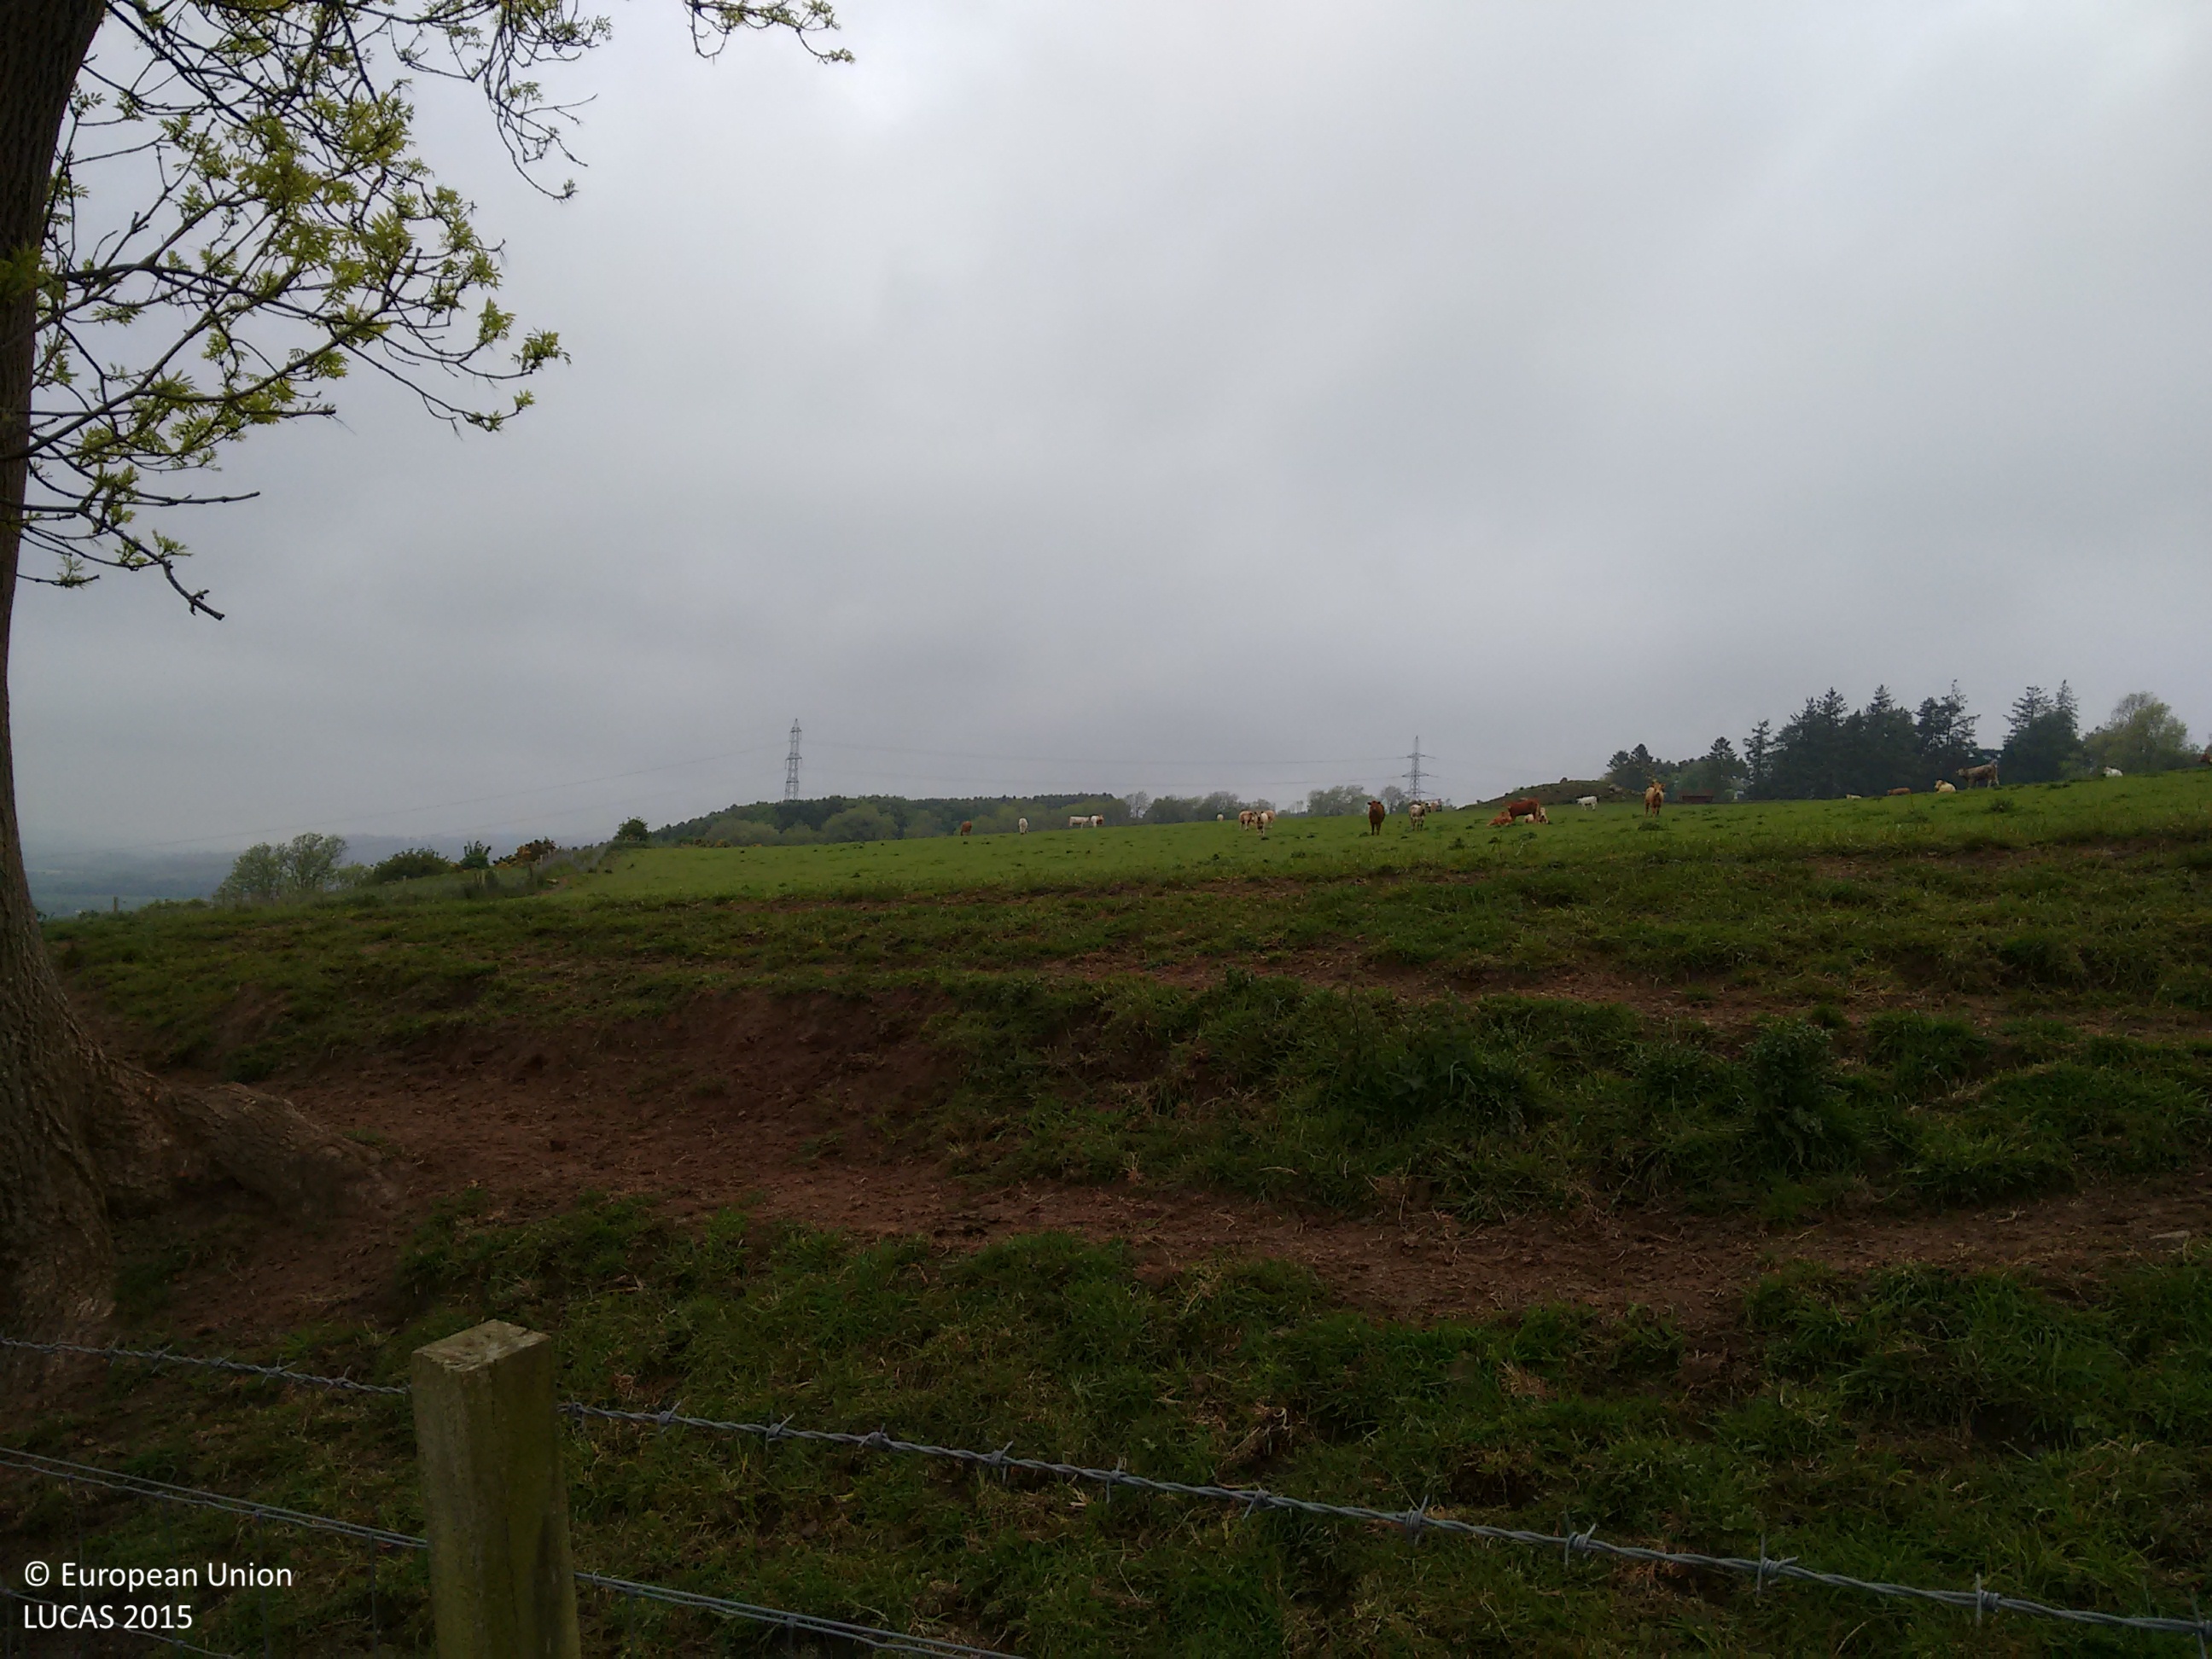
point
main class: Grassland
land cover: Grassland without tree/shrub cover
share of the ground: > 75 %
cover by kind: herbaceous plants 100 %
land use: Agriculture (excluding fallow land and kitchen gardens)
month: June
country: GB
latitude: 56.3686
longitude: -3.4635
